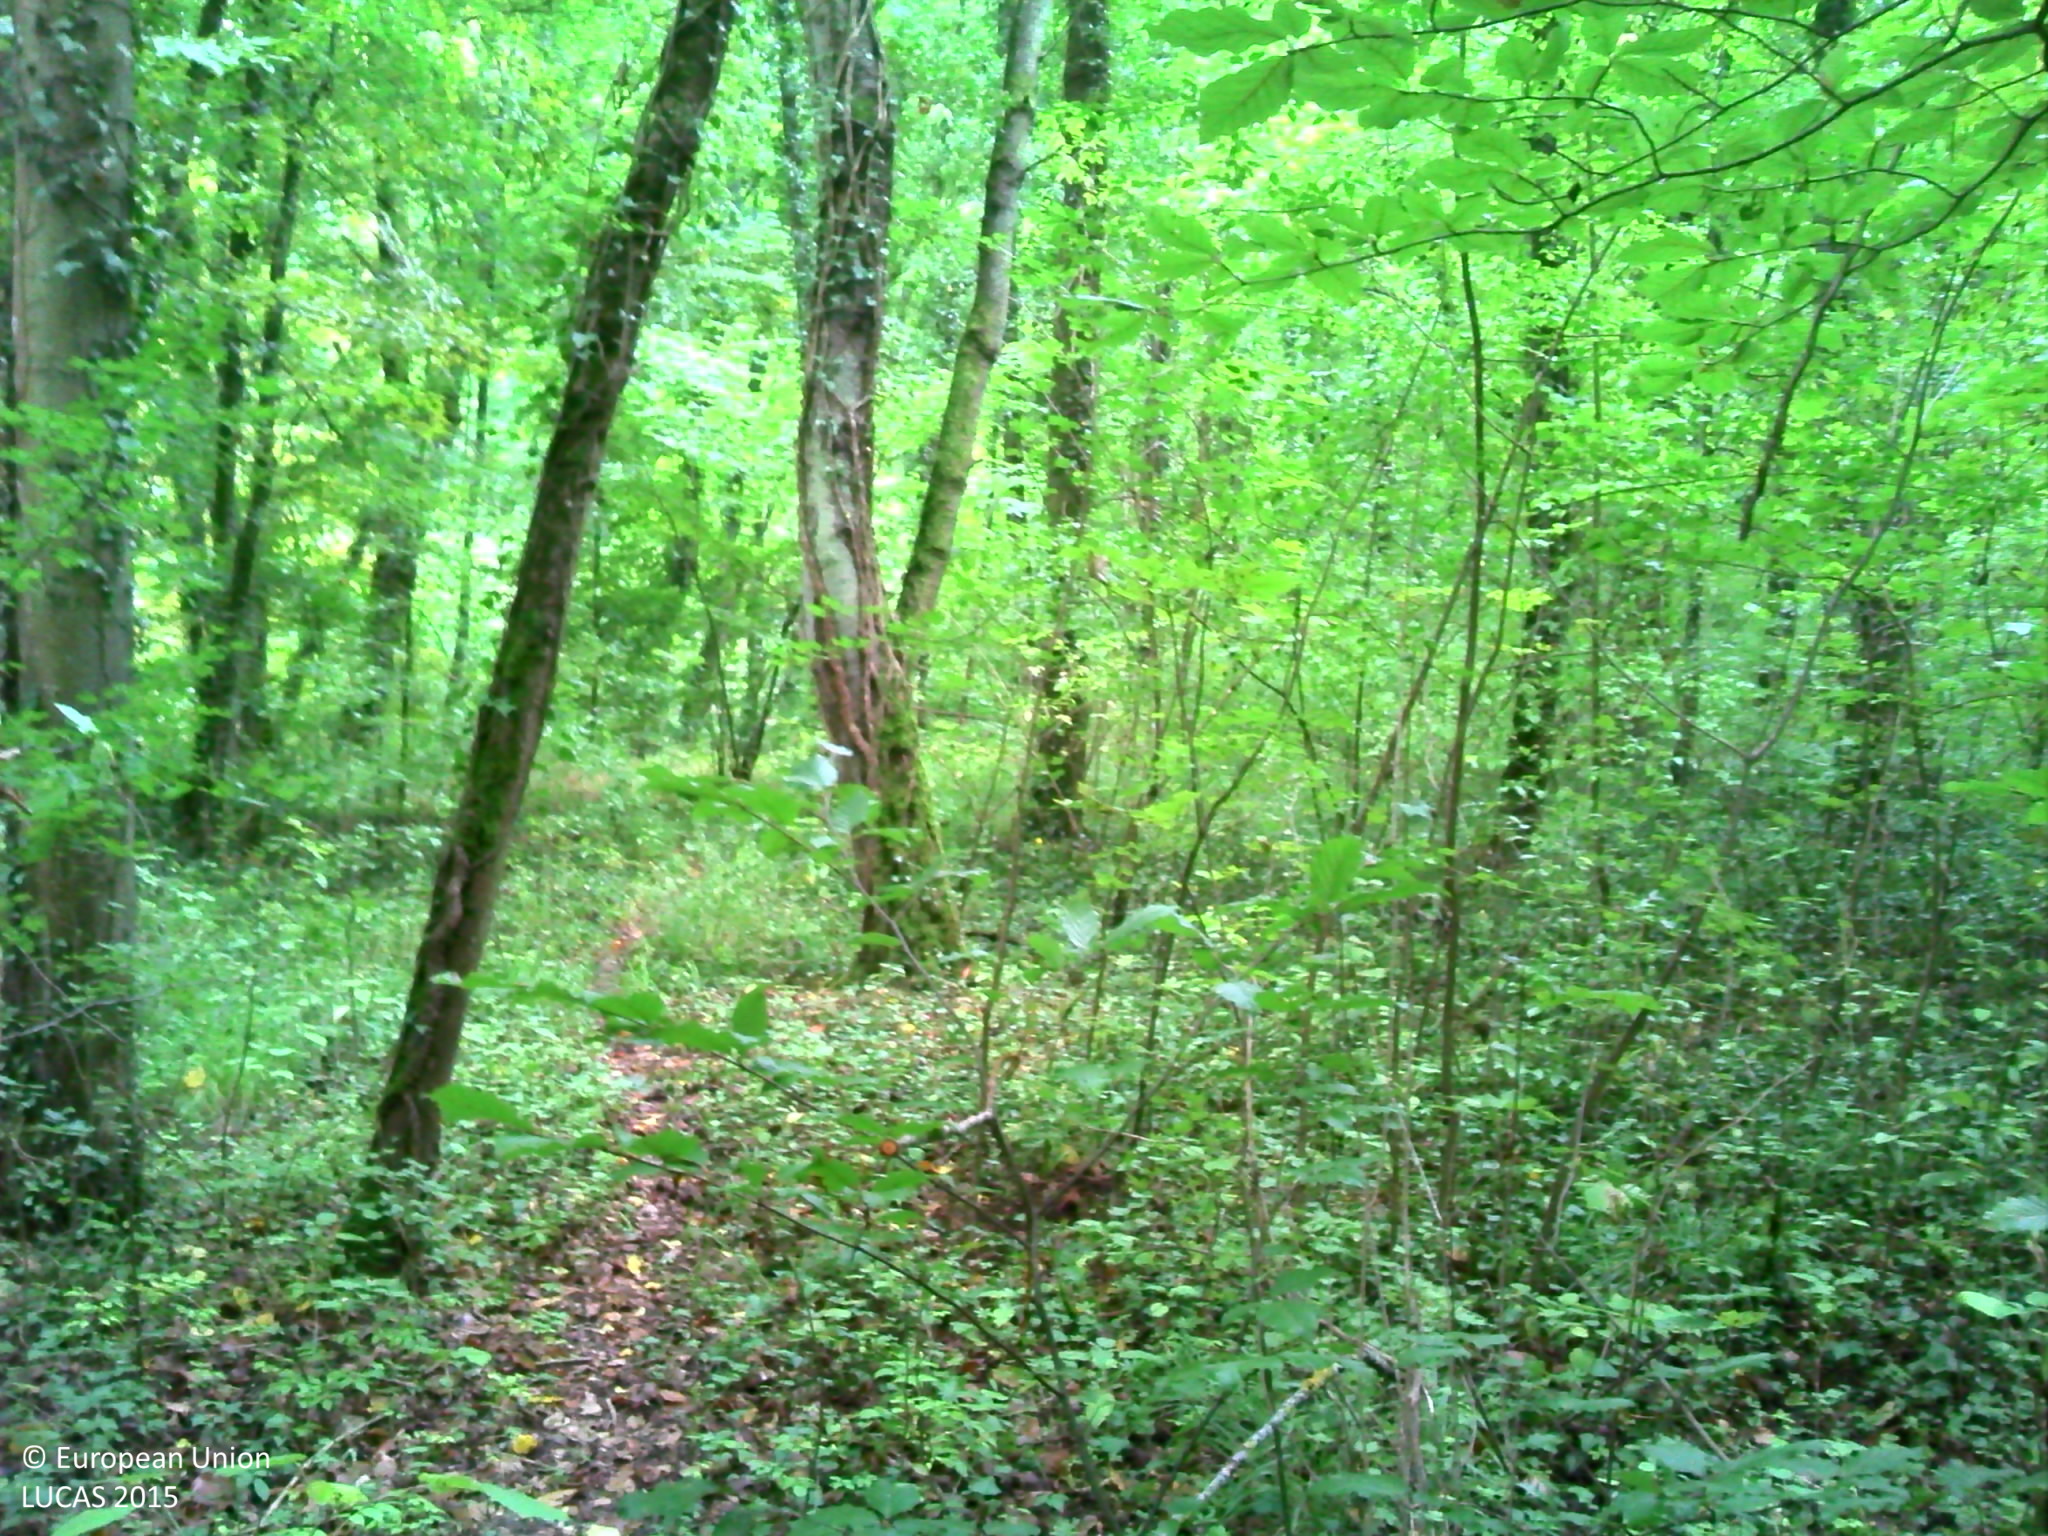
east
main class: Woodland
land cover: Broadleaved woodland
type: mesophytic deciduous forest
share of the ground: > 75 %
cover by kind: broadleaved forest trees 90 %, herbaceous plants 5 %, consolidated bare surface 5 %
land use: Forestry
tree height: > 5 m
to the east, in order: Broadleaved woodland; Tracks; Grass margins; Fences; Grassland without tree/shrub cover; Fences; Broadleaved woodland; Fences; Grassland without tree/shrub cover; Fences; Broadleaved woodland
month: September
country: FR
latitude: 48.8727
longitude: 6.0322
